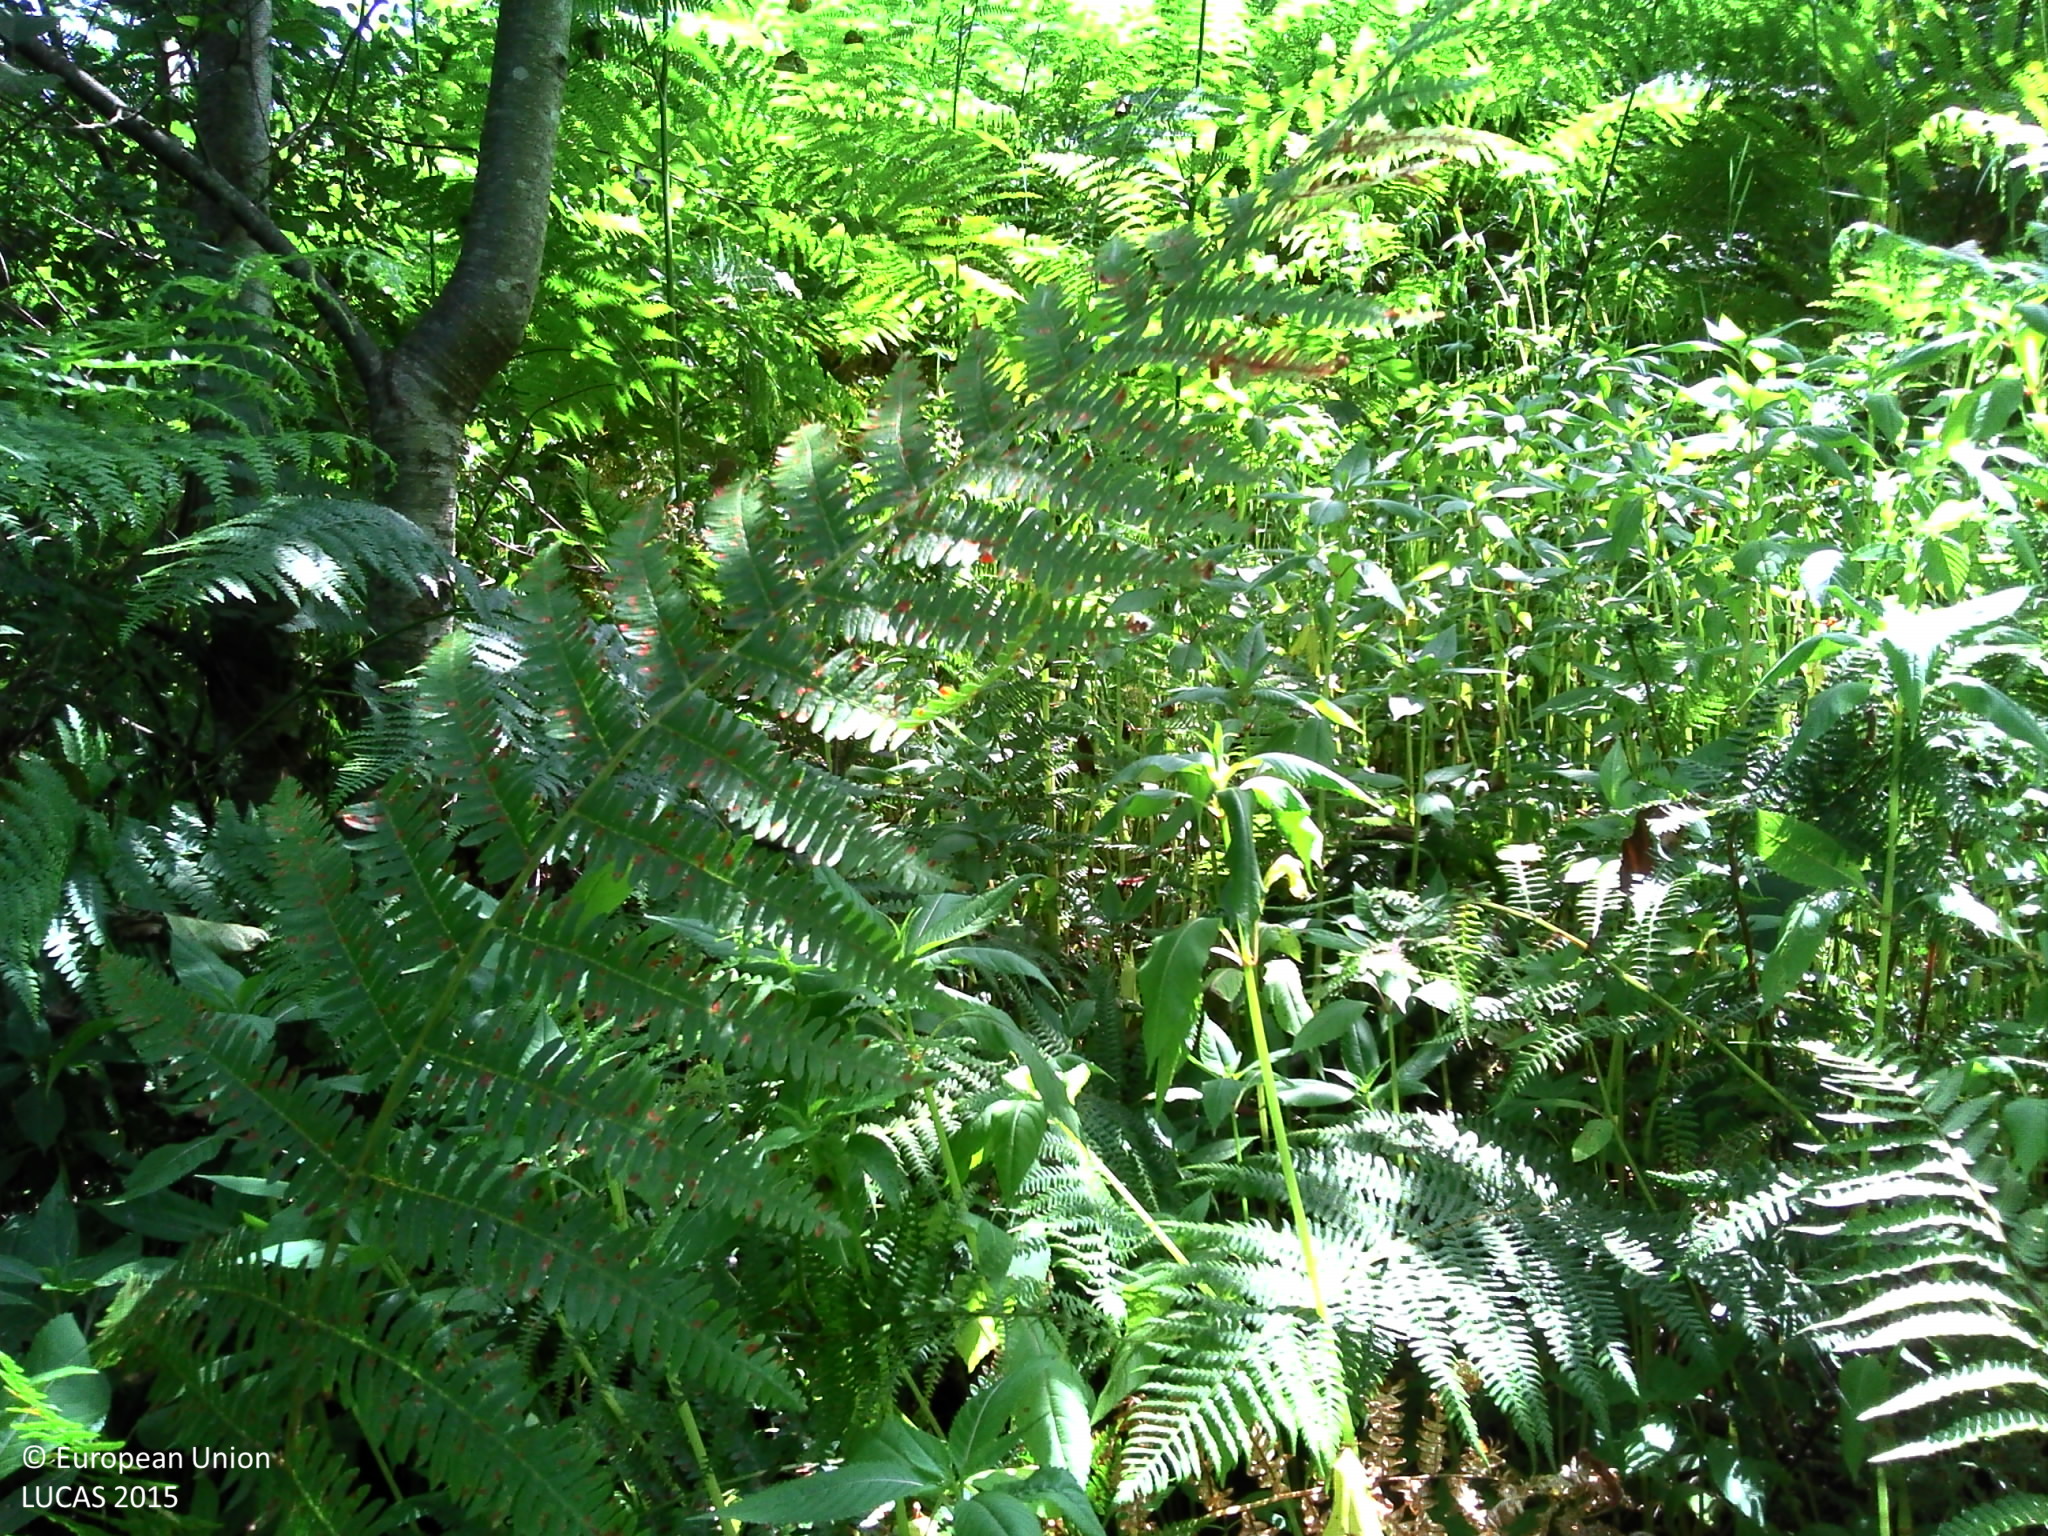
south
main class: Shrubland
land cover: Shrubland without tree cover
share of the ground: > 75 %
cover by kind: shrubs 40 %, herbaceous plants 30 %, lichens and mosses 30 %
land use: Semi-natural and natural areas not in use
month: July
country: FR
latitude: 43.0053
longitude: 0.8884
